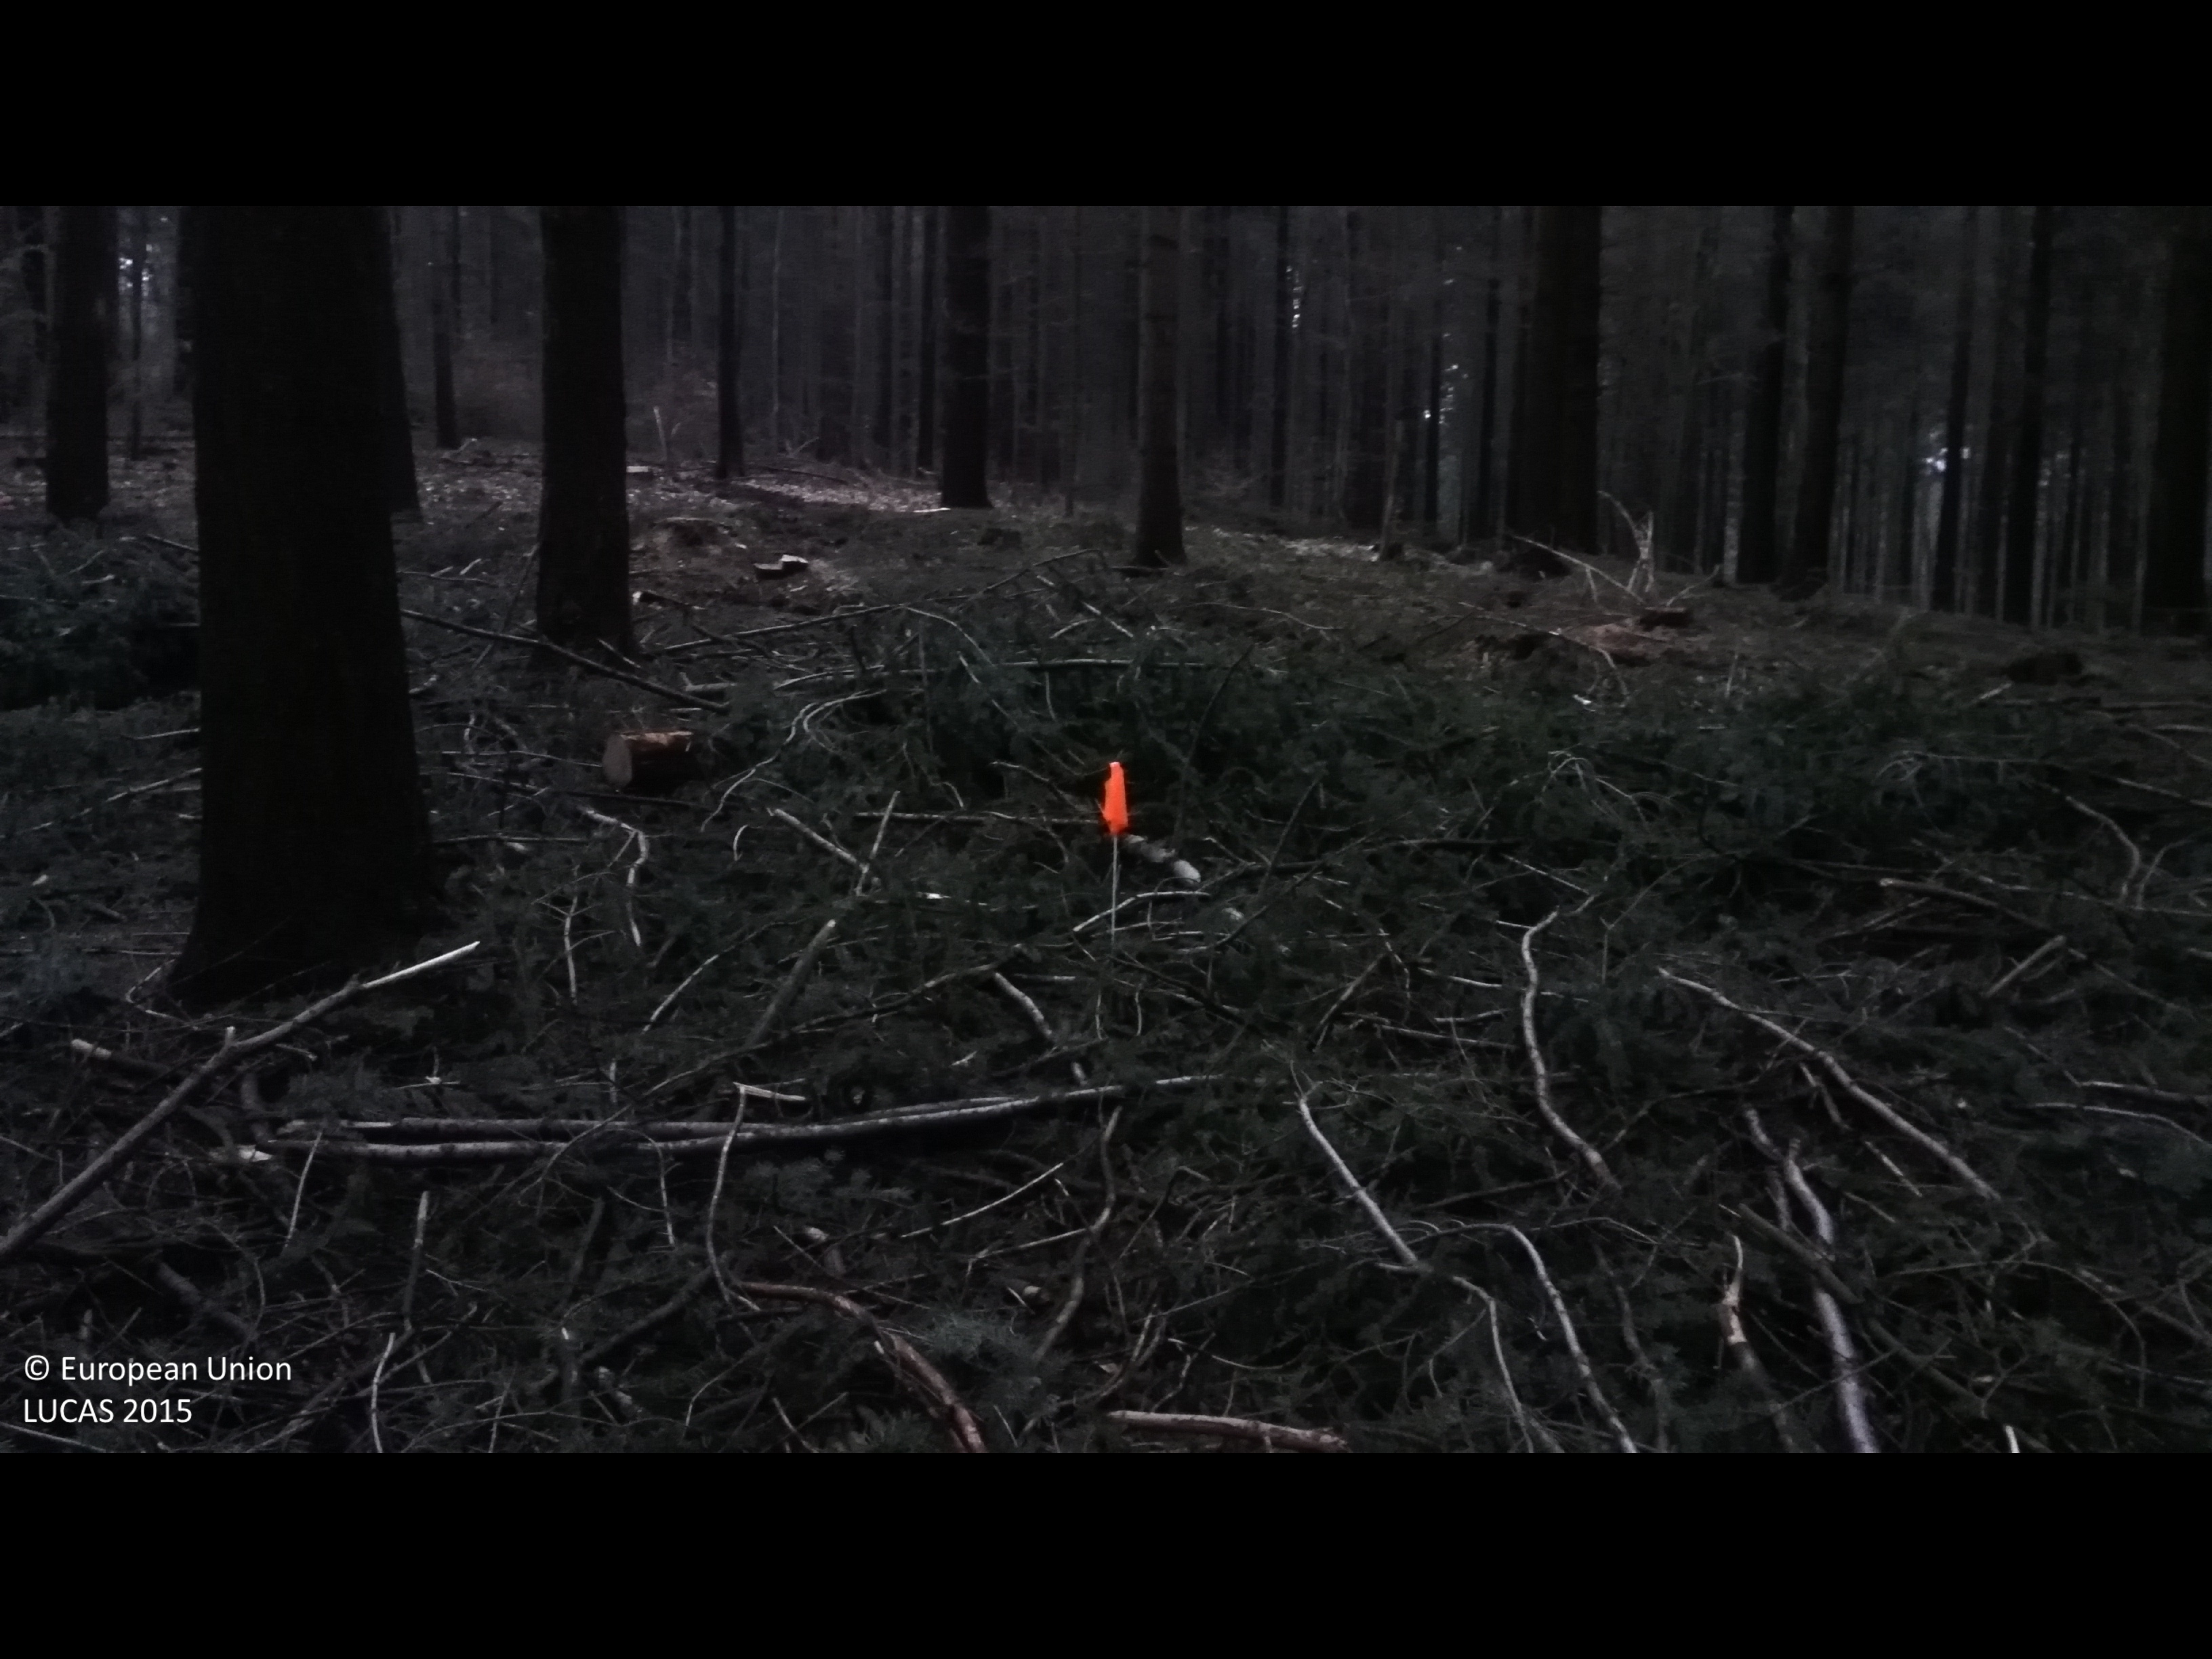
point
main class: Woodland
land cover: Pine dominated coniferous woodland
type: hemiboreal forest and nemoral coniferous forest and mixed broadleaved-coniferous forest
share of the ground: > 75 %
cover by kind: coniferous forest trees 100 %
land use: Forestry
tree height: > 5 m
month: January
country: DE
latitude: 53.4199
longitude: 9.9248
